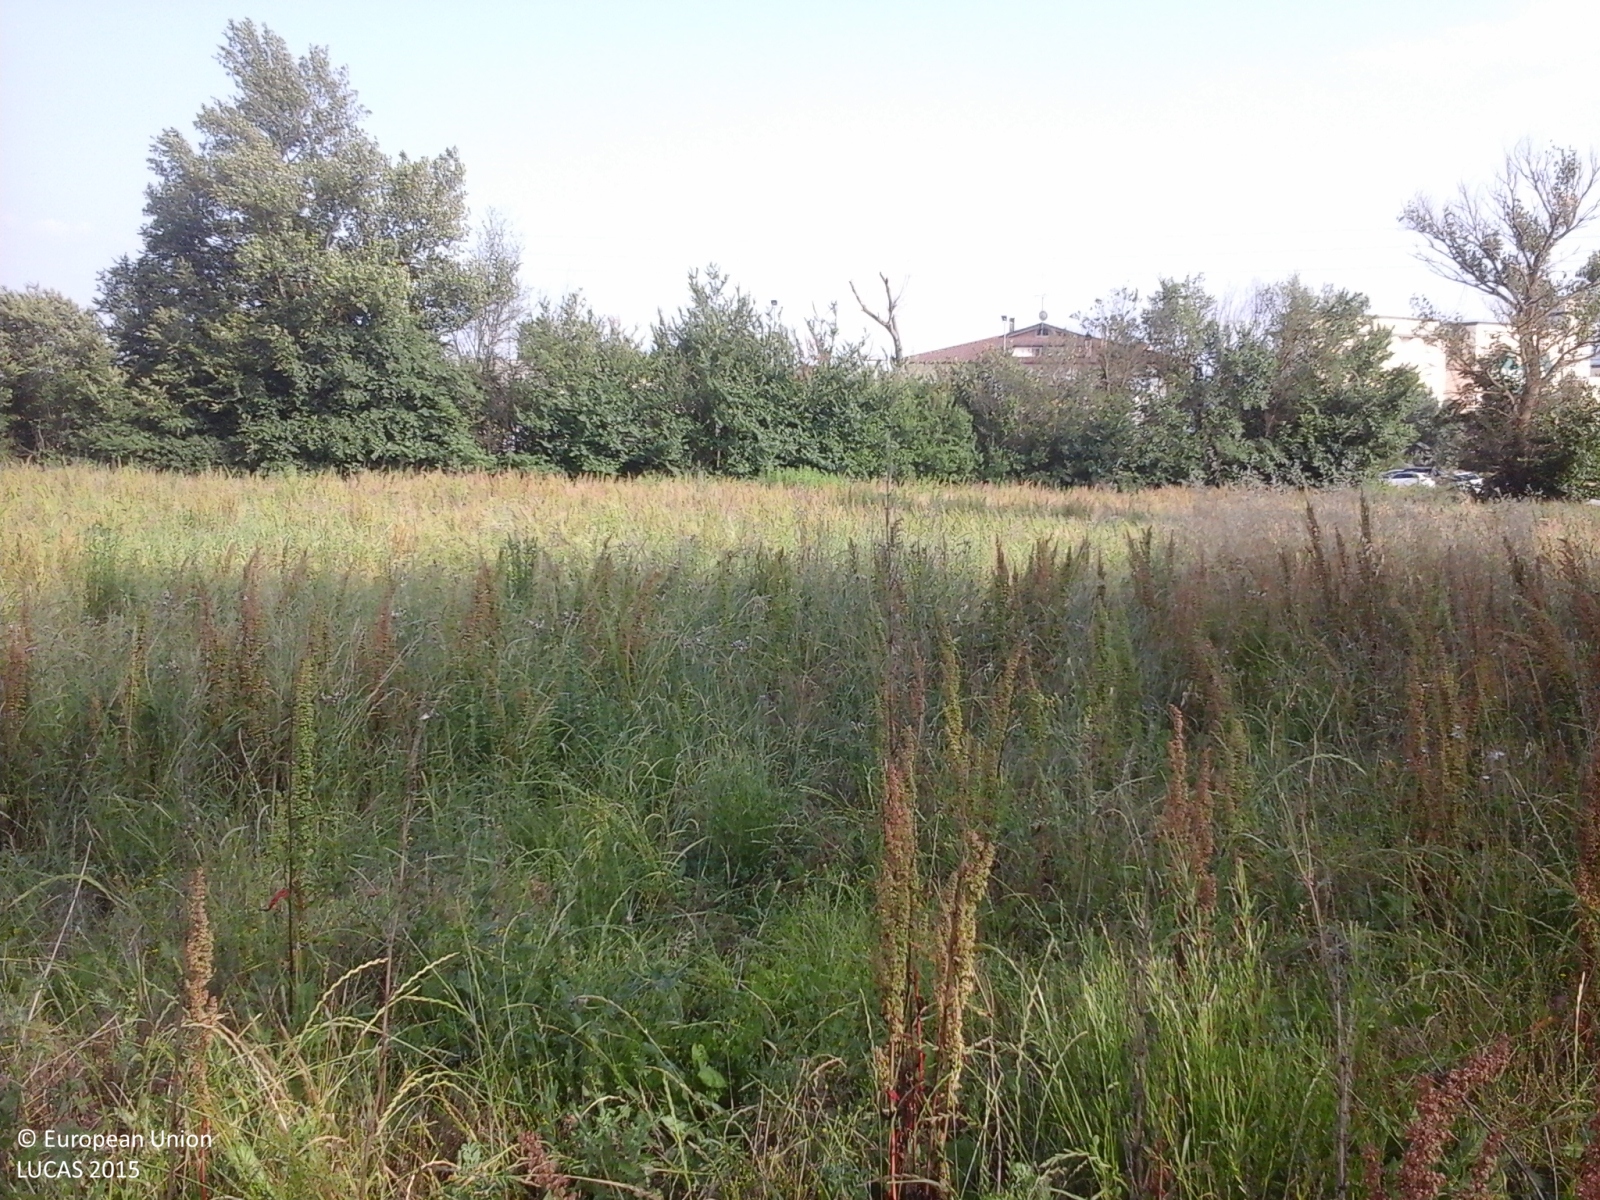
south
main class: Grassland
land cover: Spontaneously vegetated surfaces
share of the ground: > 75 %
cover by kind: herbaceous plants 100 %
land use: Fallow land
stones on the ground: < 10 %
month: June
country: IT
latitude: 41.0766
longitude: 15.1108
